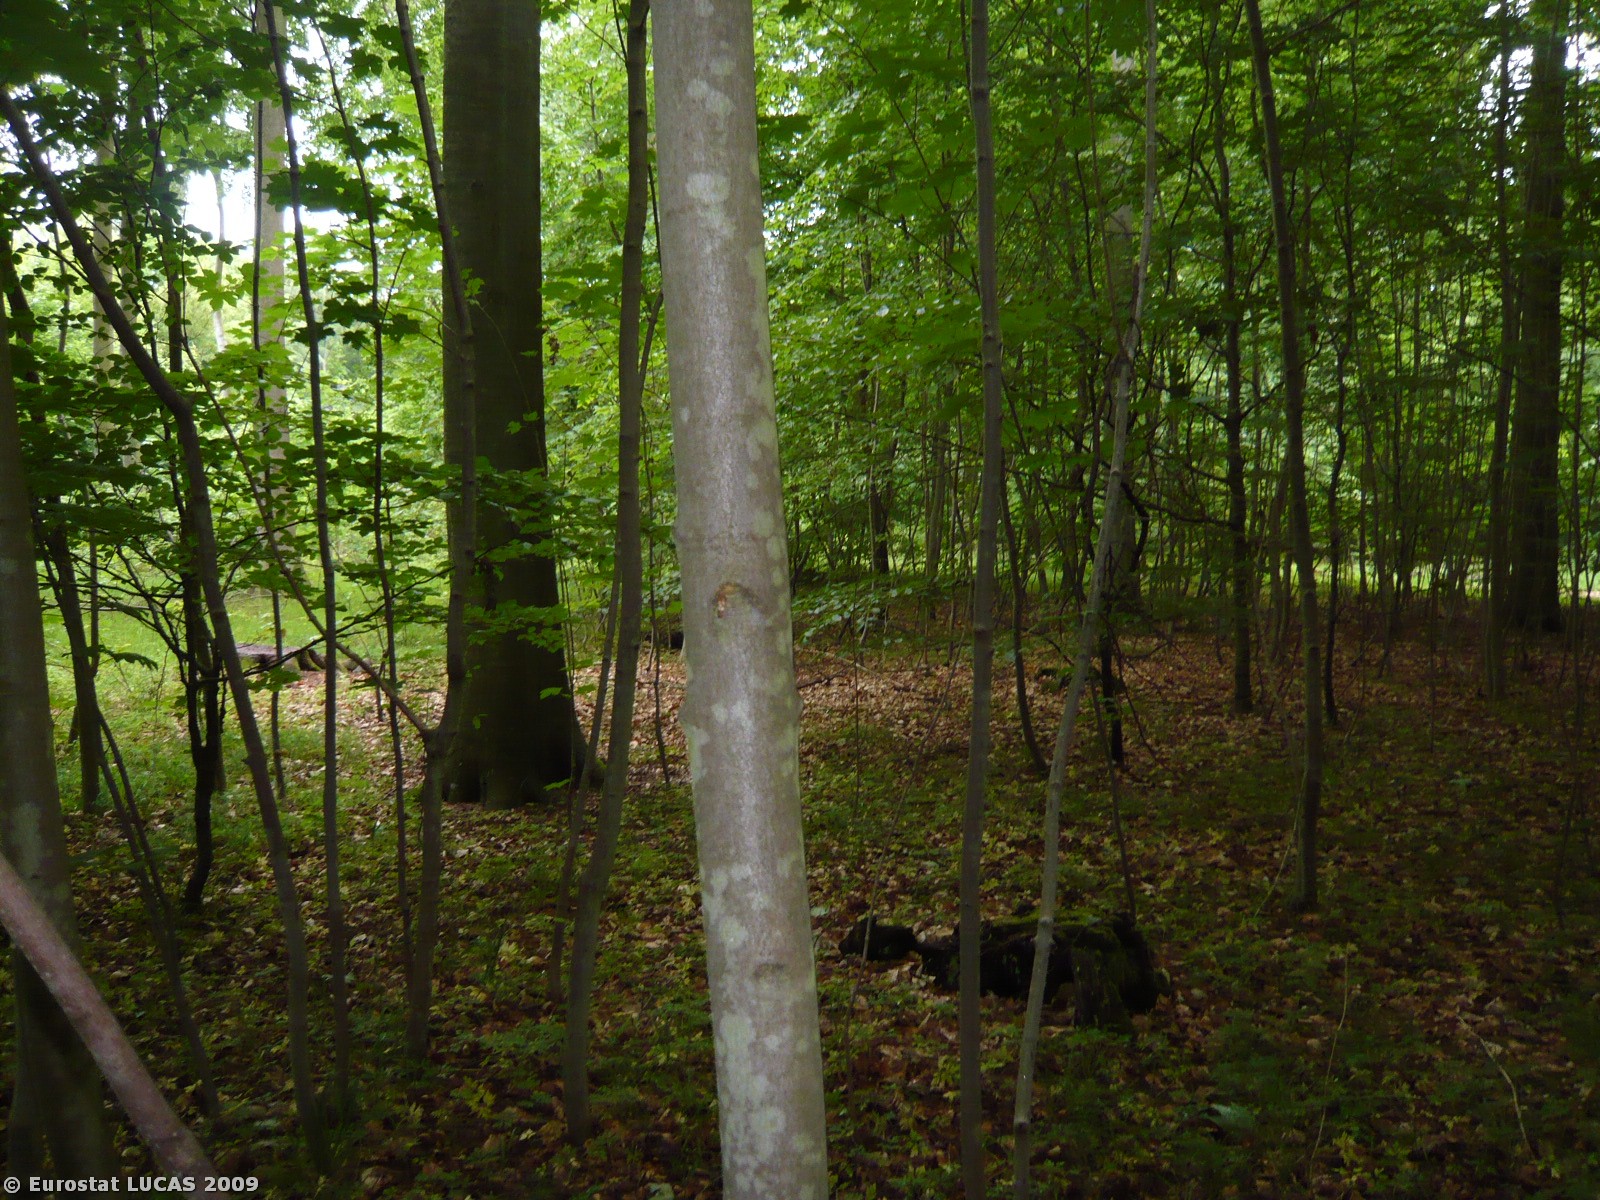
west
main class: Woodland
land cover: Broadleaved woodland
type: mesophytic deciduous forest
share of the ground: > 75 %
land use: Forestry
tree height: > 5 m
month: June
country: DK
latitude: 54.7007
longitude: 11.8144
